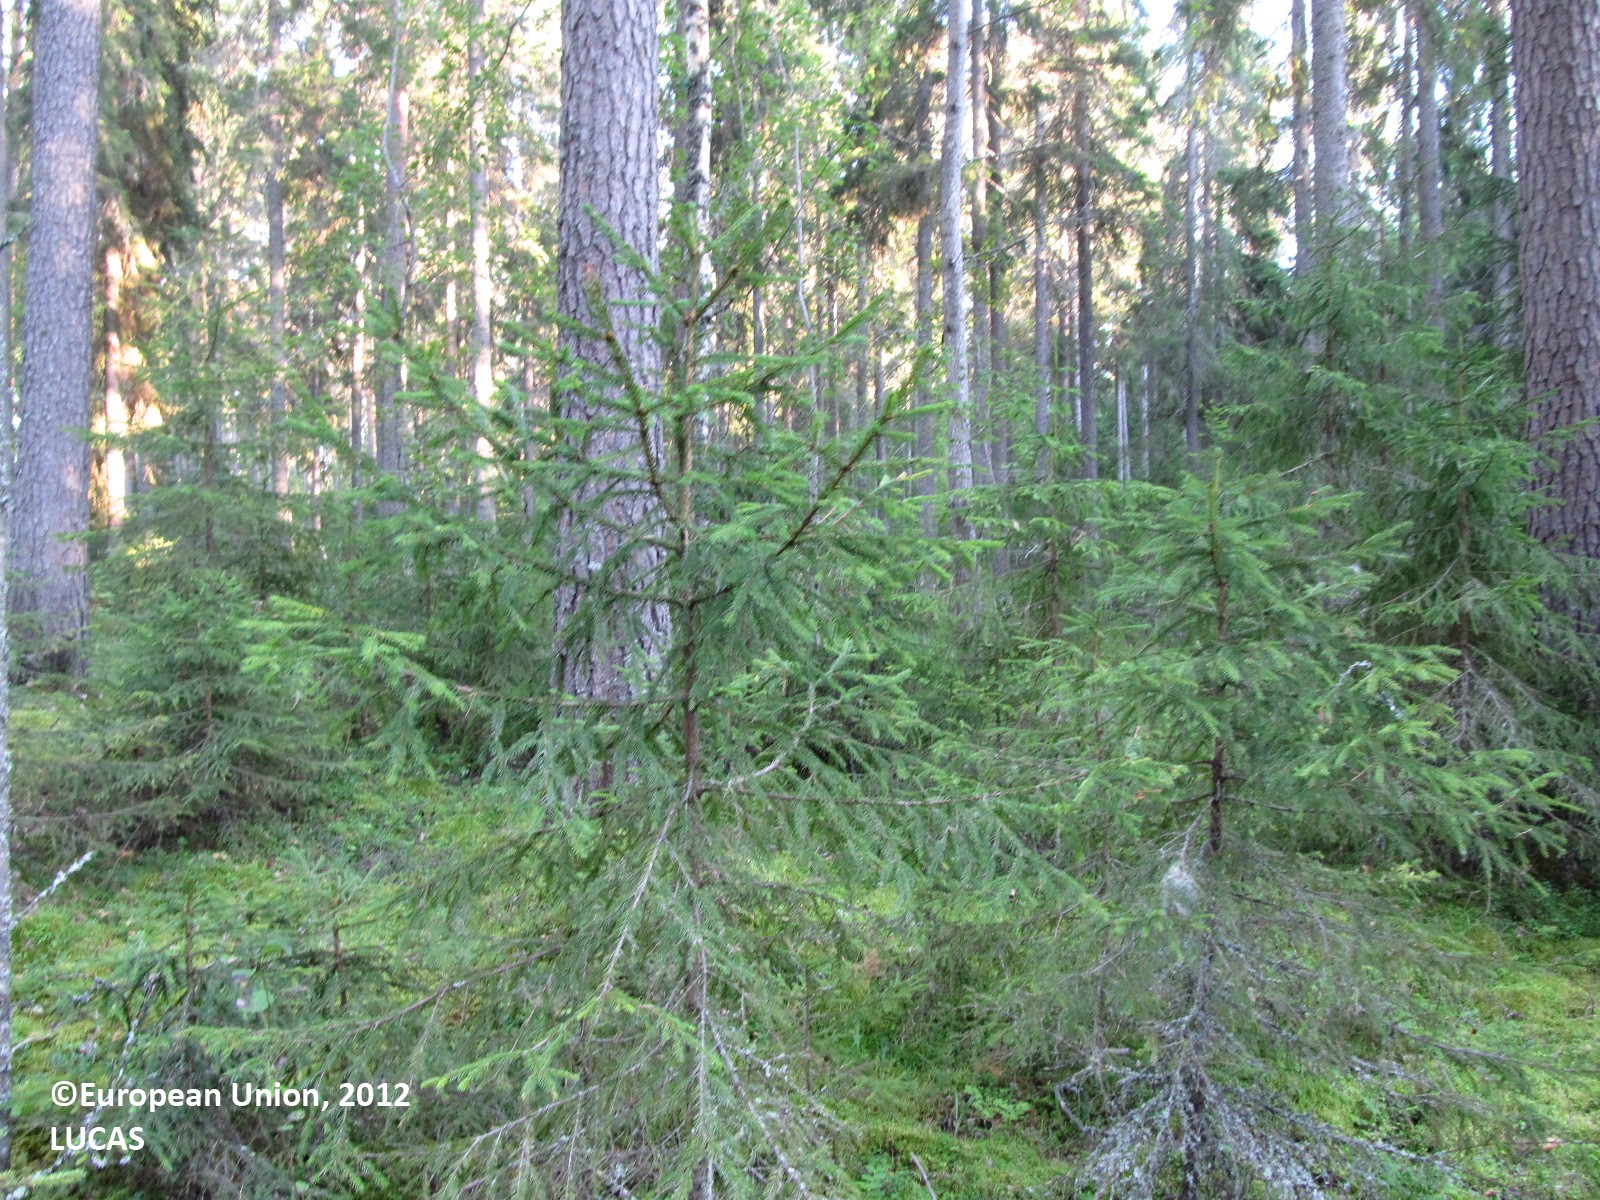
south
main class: Woodland
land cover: Other coniferous woodland
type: boreal forest
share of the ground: 50 - 75 %
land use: Forestry
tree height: > 5 m
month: August
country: FI
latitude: 62.1057
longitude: 27.7098
